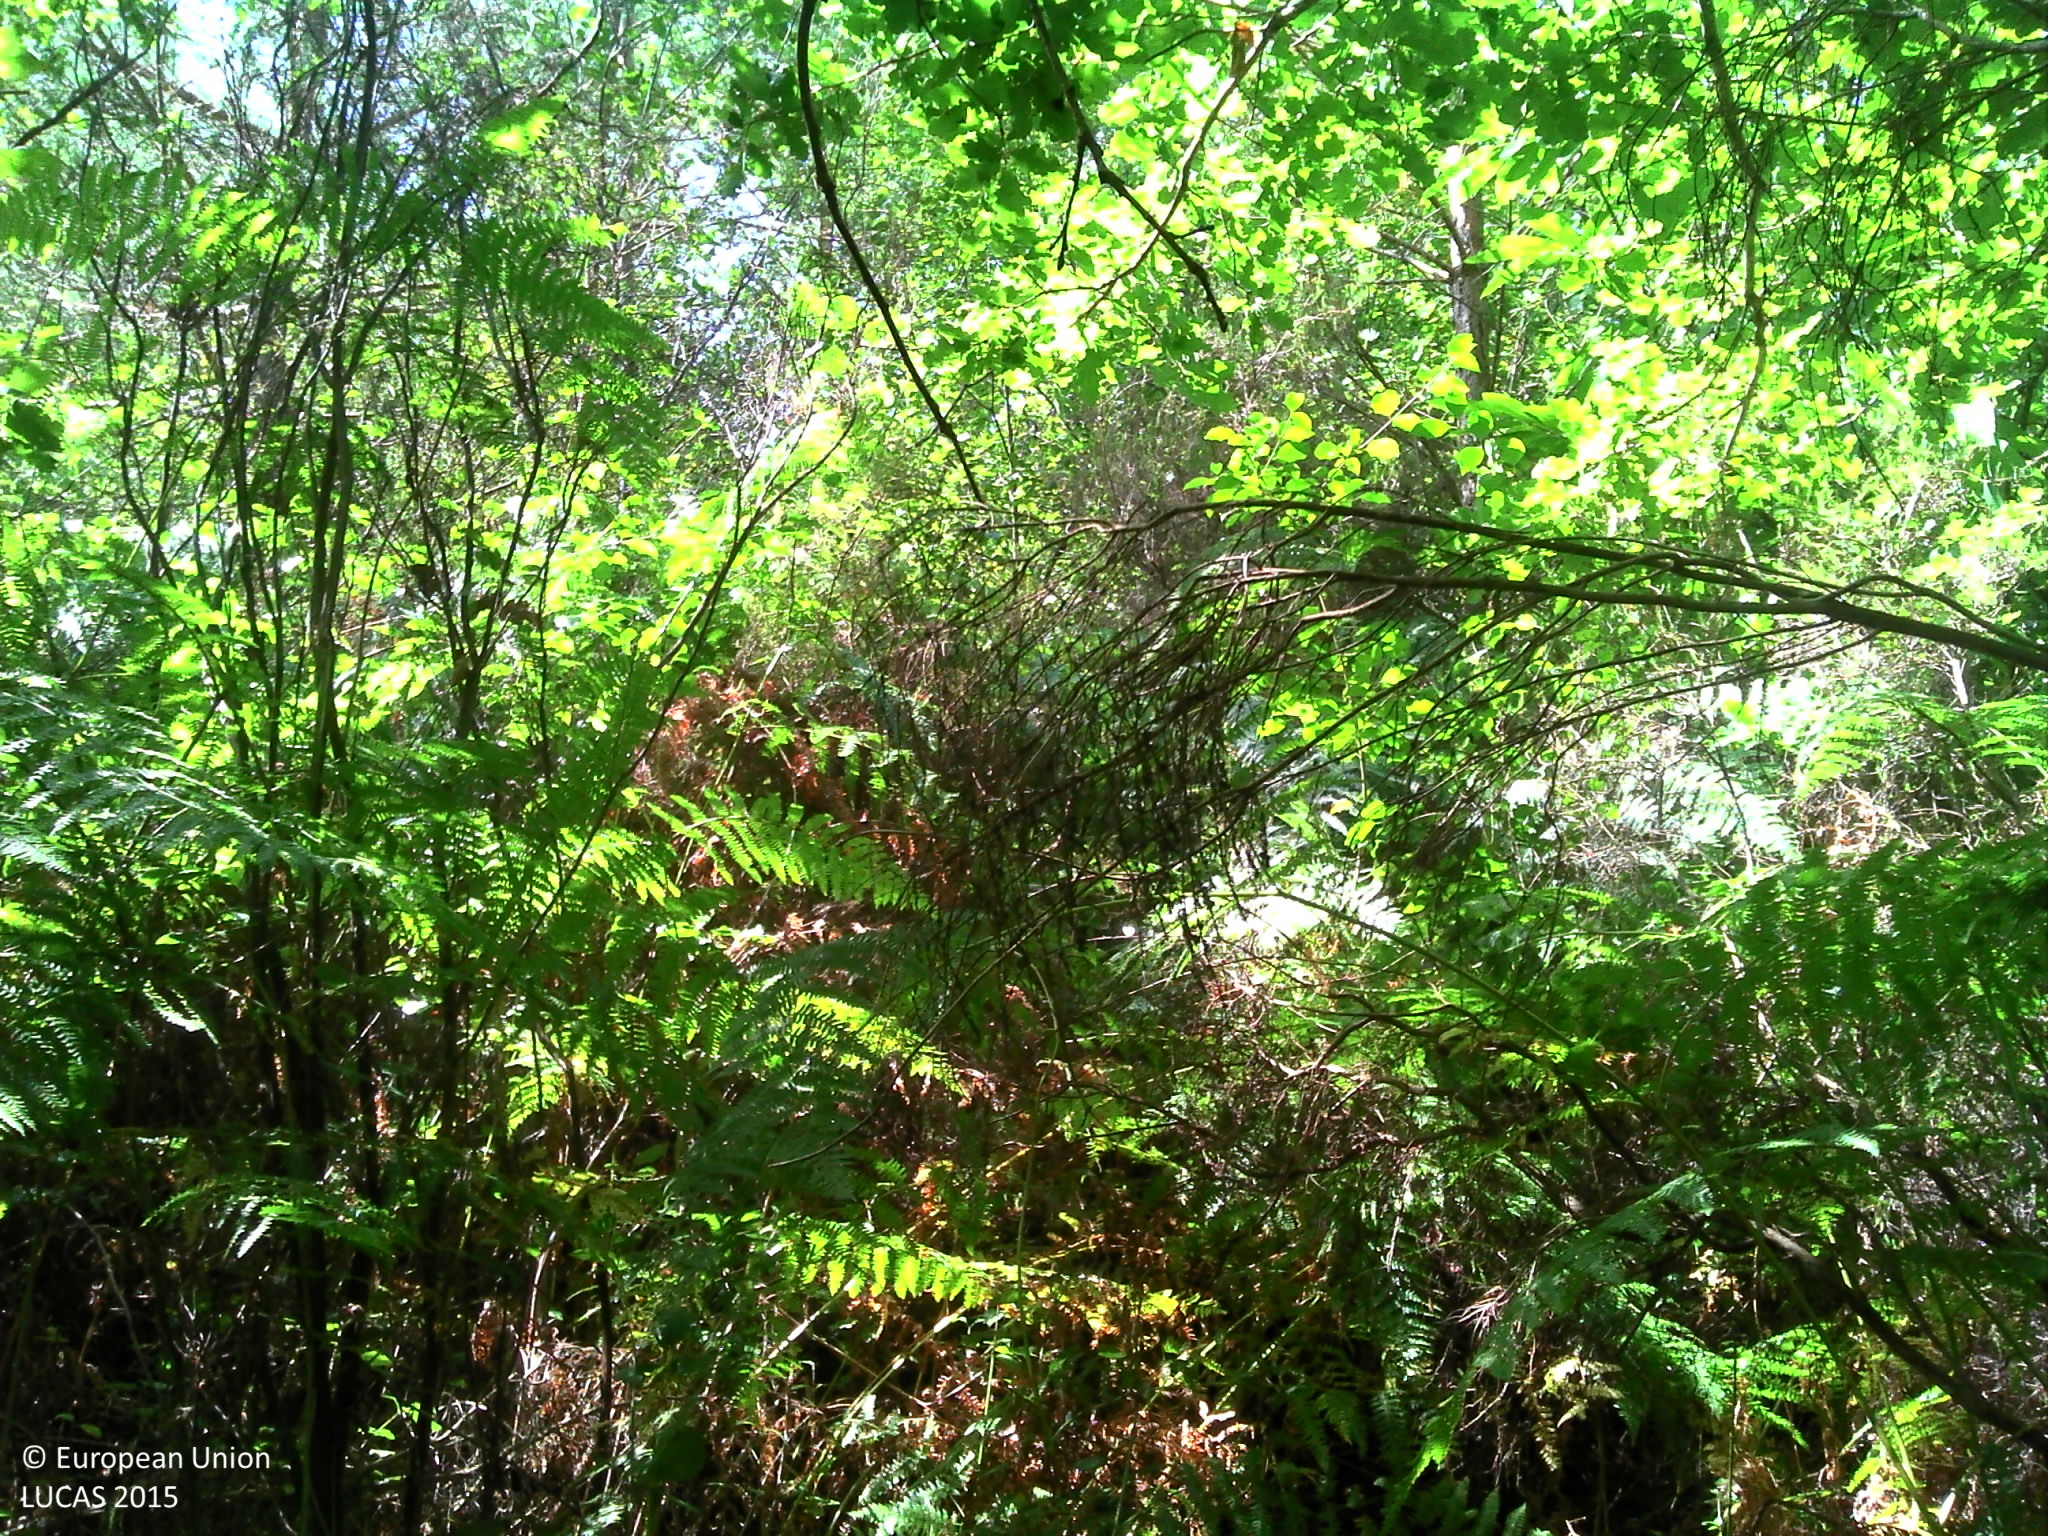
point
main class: Woodland
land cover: Broadleaved woodland
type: mesophytic deciduous forest
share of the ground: > 75 %
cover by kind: broadleaved forest trees 70 %, shrubs 10 %, herbaceous plants 10 %, coniferous forest trees 5 %, lichens and mosses 5 %
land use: Forestry
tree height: > 5 m
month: August
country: FR
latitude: 45.3345
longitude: 0.7640
